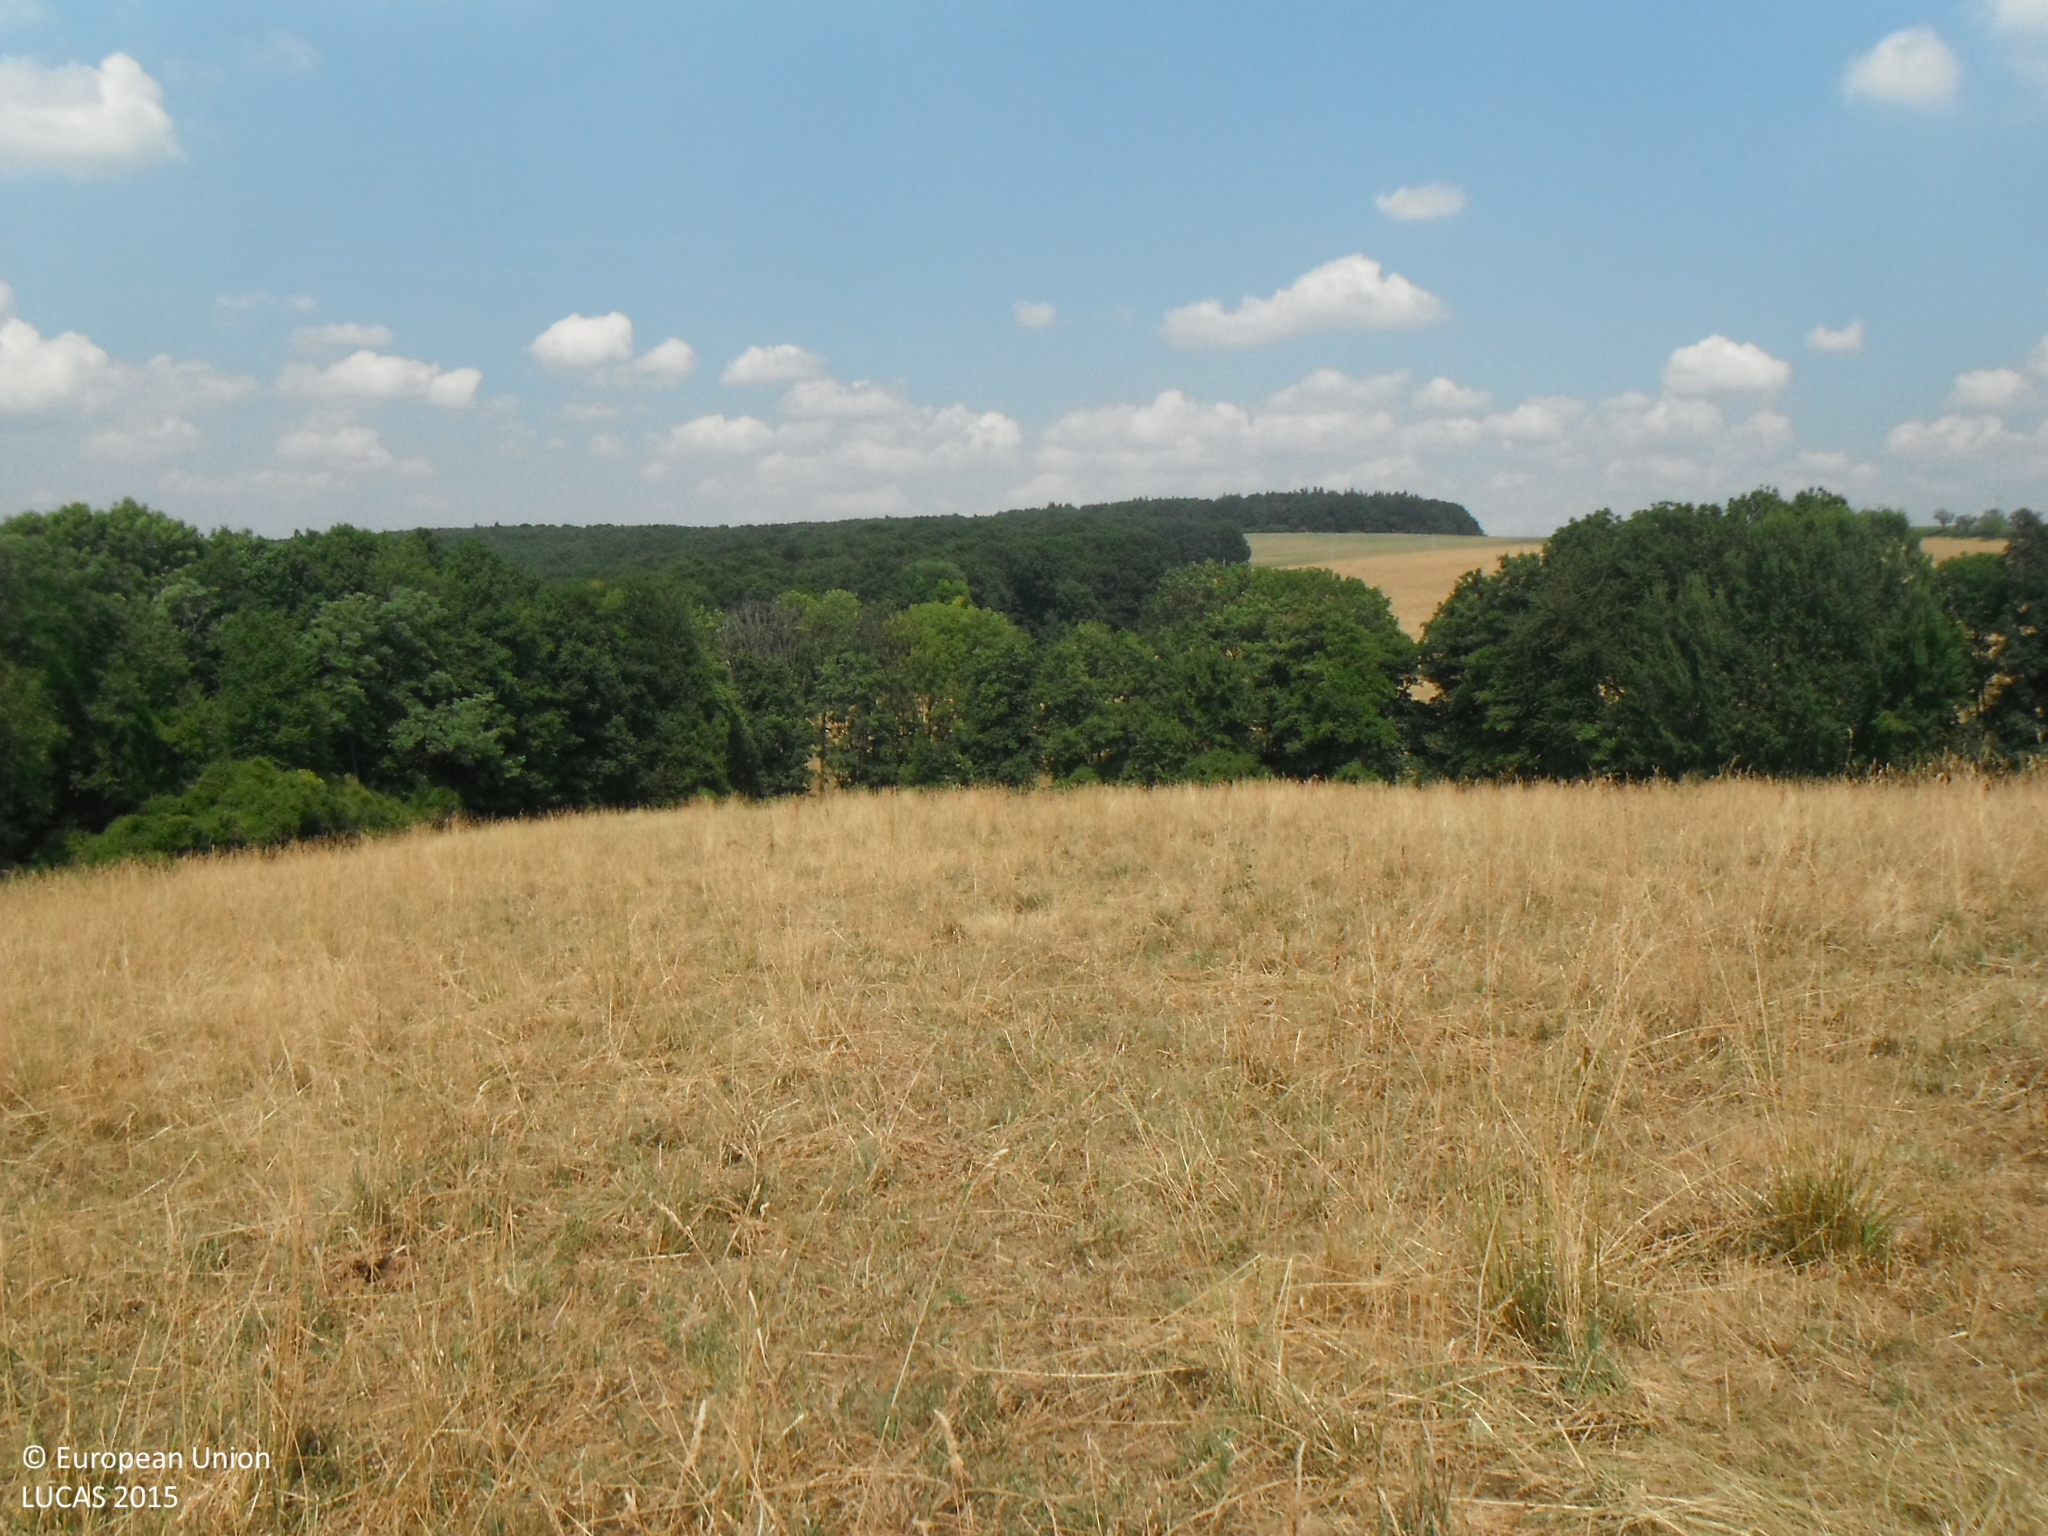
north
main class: Grassland
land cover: Grassland without tree/shrub cover
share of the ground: > 75 %
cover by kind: herbaceous plants 100 %
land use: Agriculture (excluding fallow land and kitchen gardens)
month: July
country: SK
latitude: 48.7088
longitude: 17.4989
